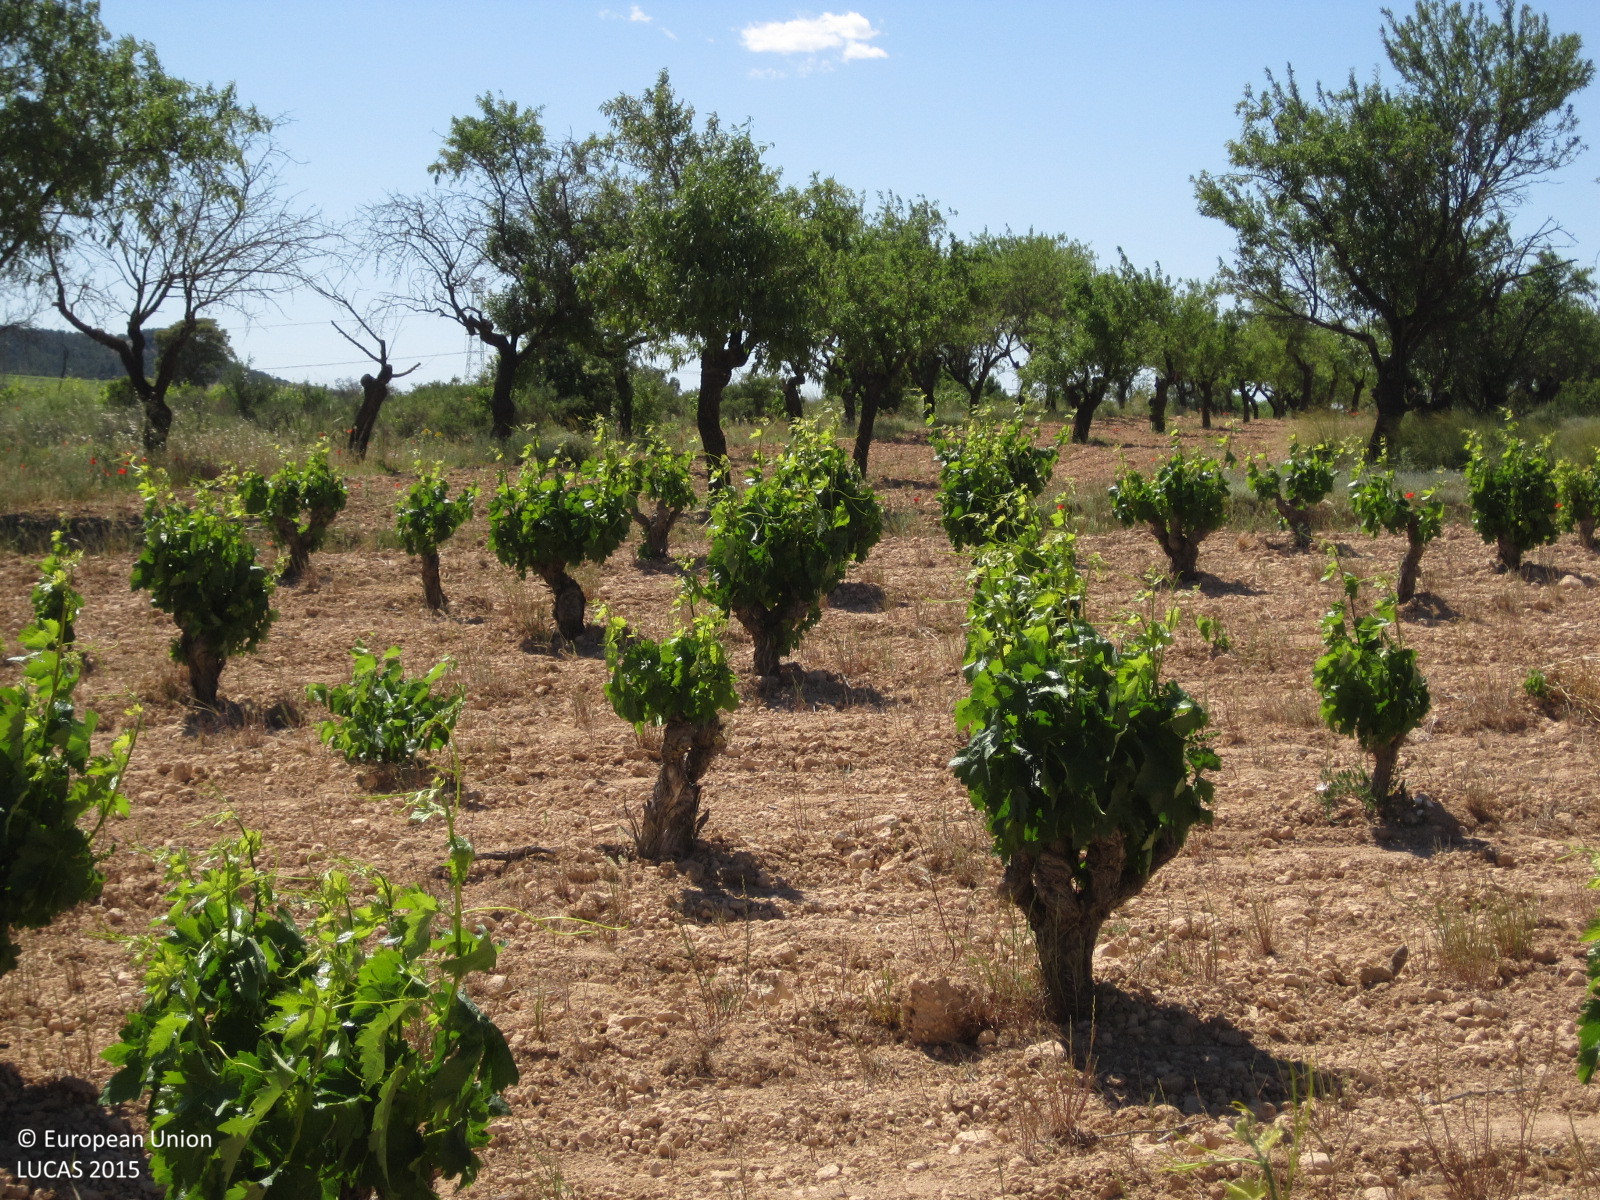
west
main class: Cropland
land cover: Vineyards
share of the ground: 10 - 25 %
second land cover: Spontaneously vegetated surfaces
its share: < 10 %
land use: Agriculture (excluding fallow land and kitchen gardens)
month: May
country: ES
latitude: 39.4172
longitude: -1.0929
